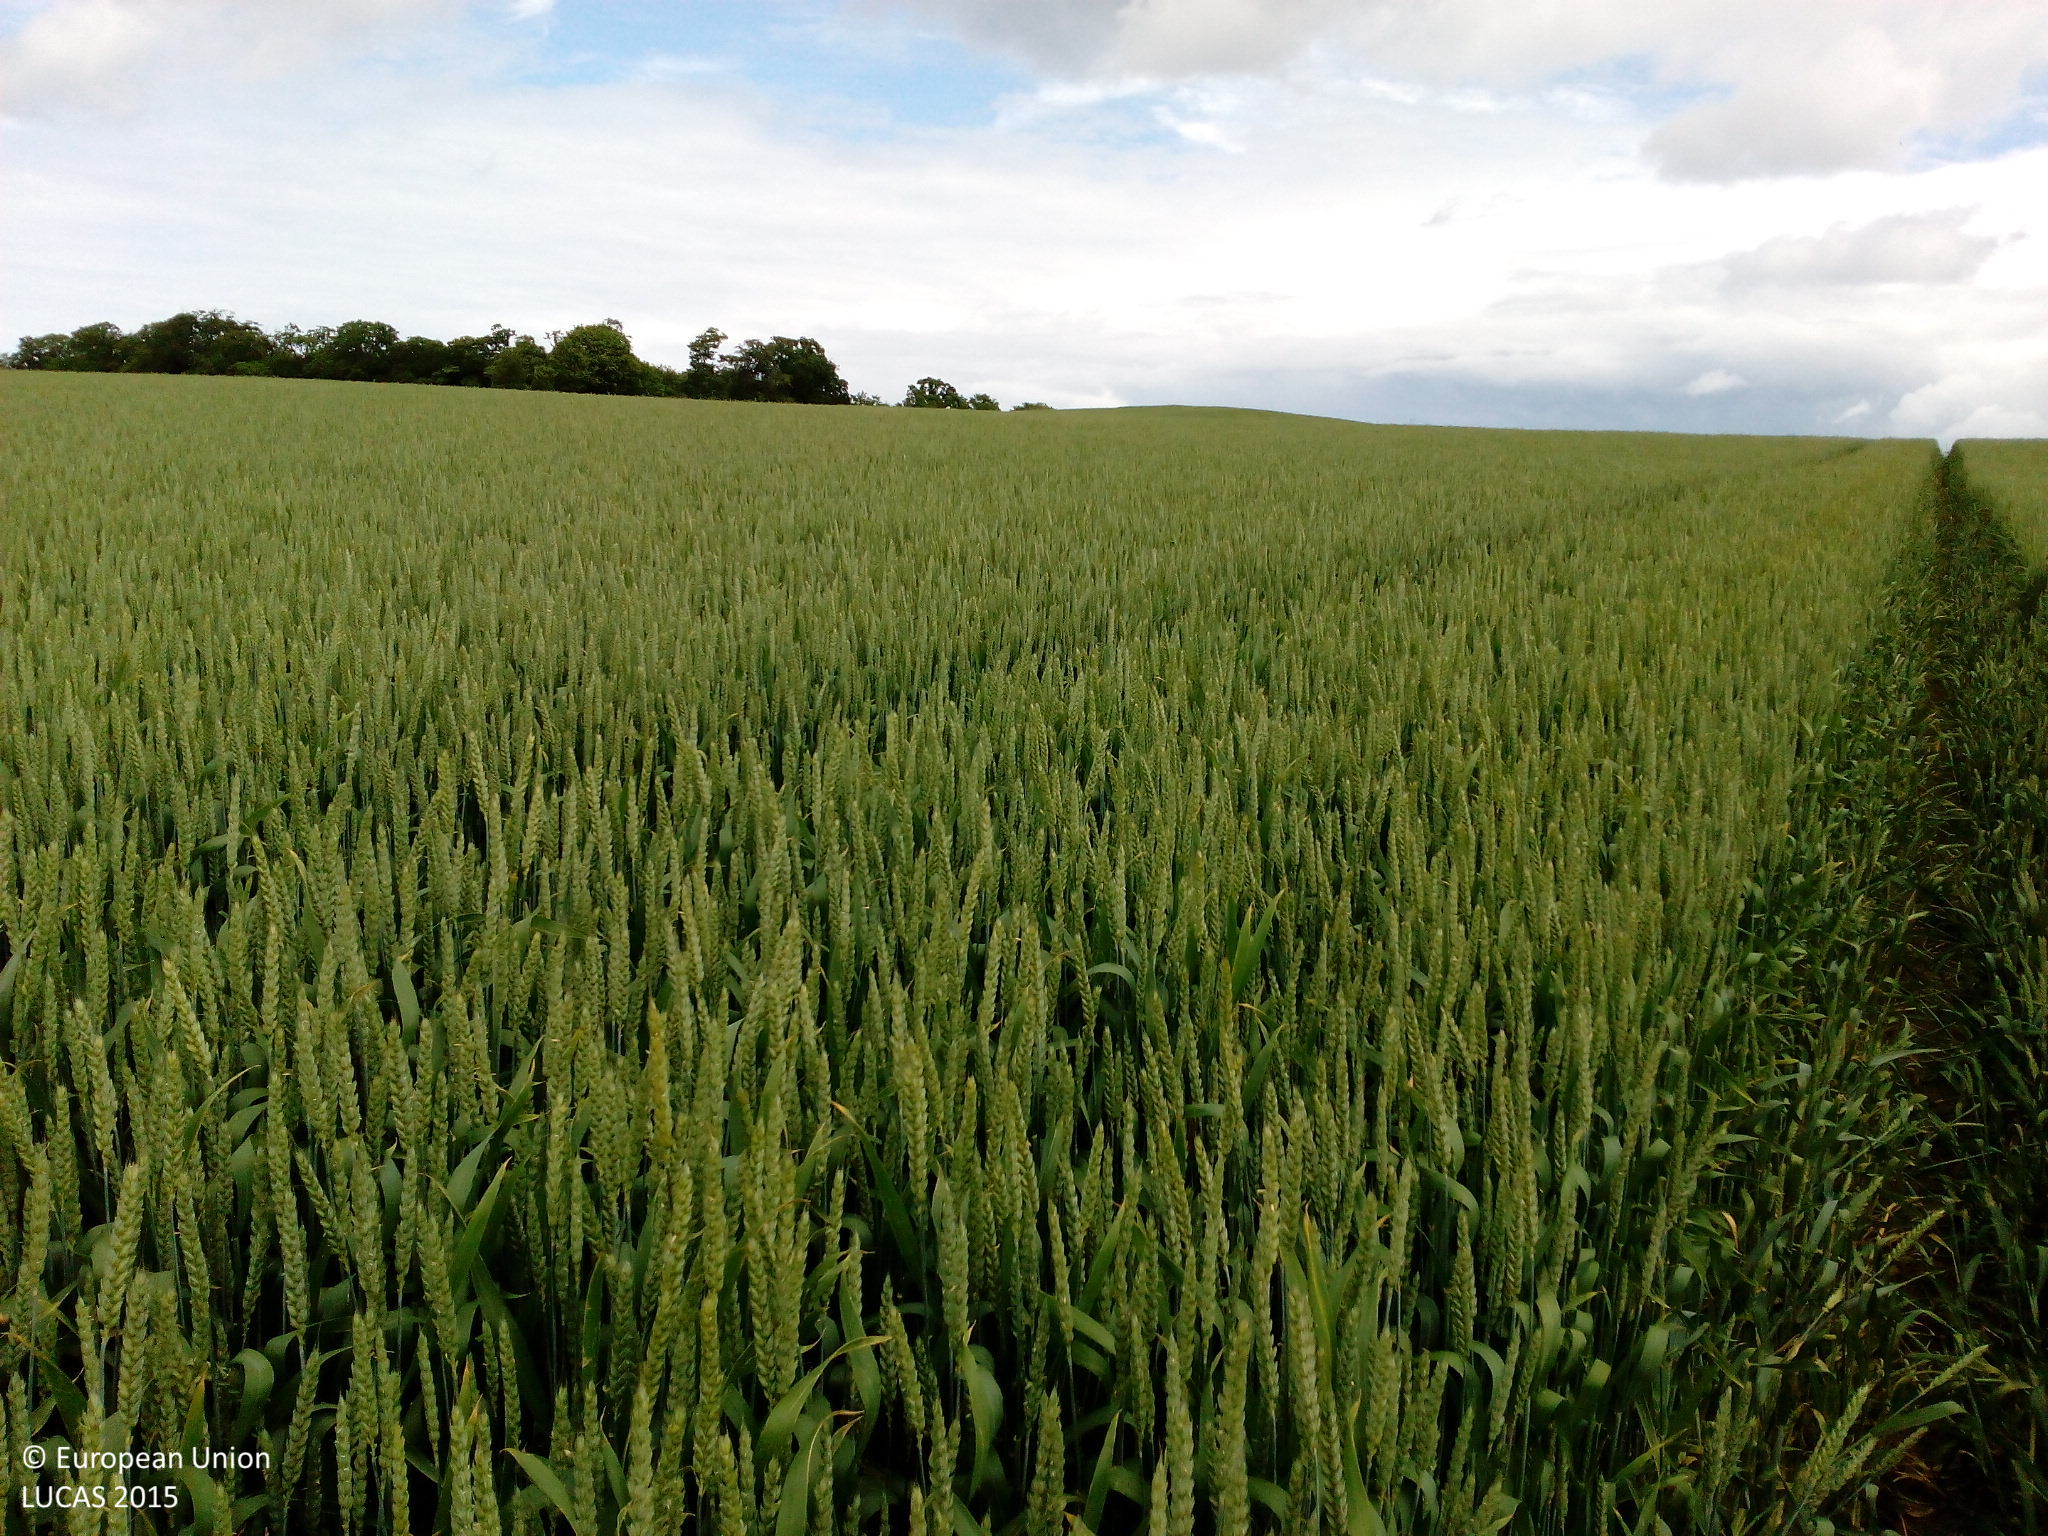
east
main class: Cropland
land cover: Common wheat
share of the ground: > 75 %
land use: Agriculture (excluding fallow land and kitchen gardens)
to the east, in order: Common wheat
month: June
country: DK
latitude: 55.0165
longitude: 10.8595
